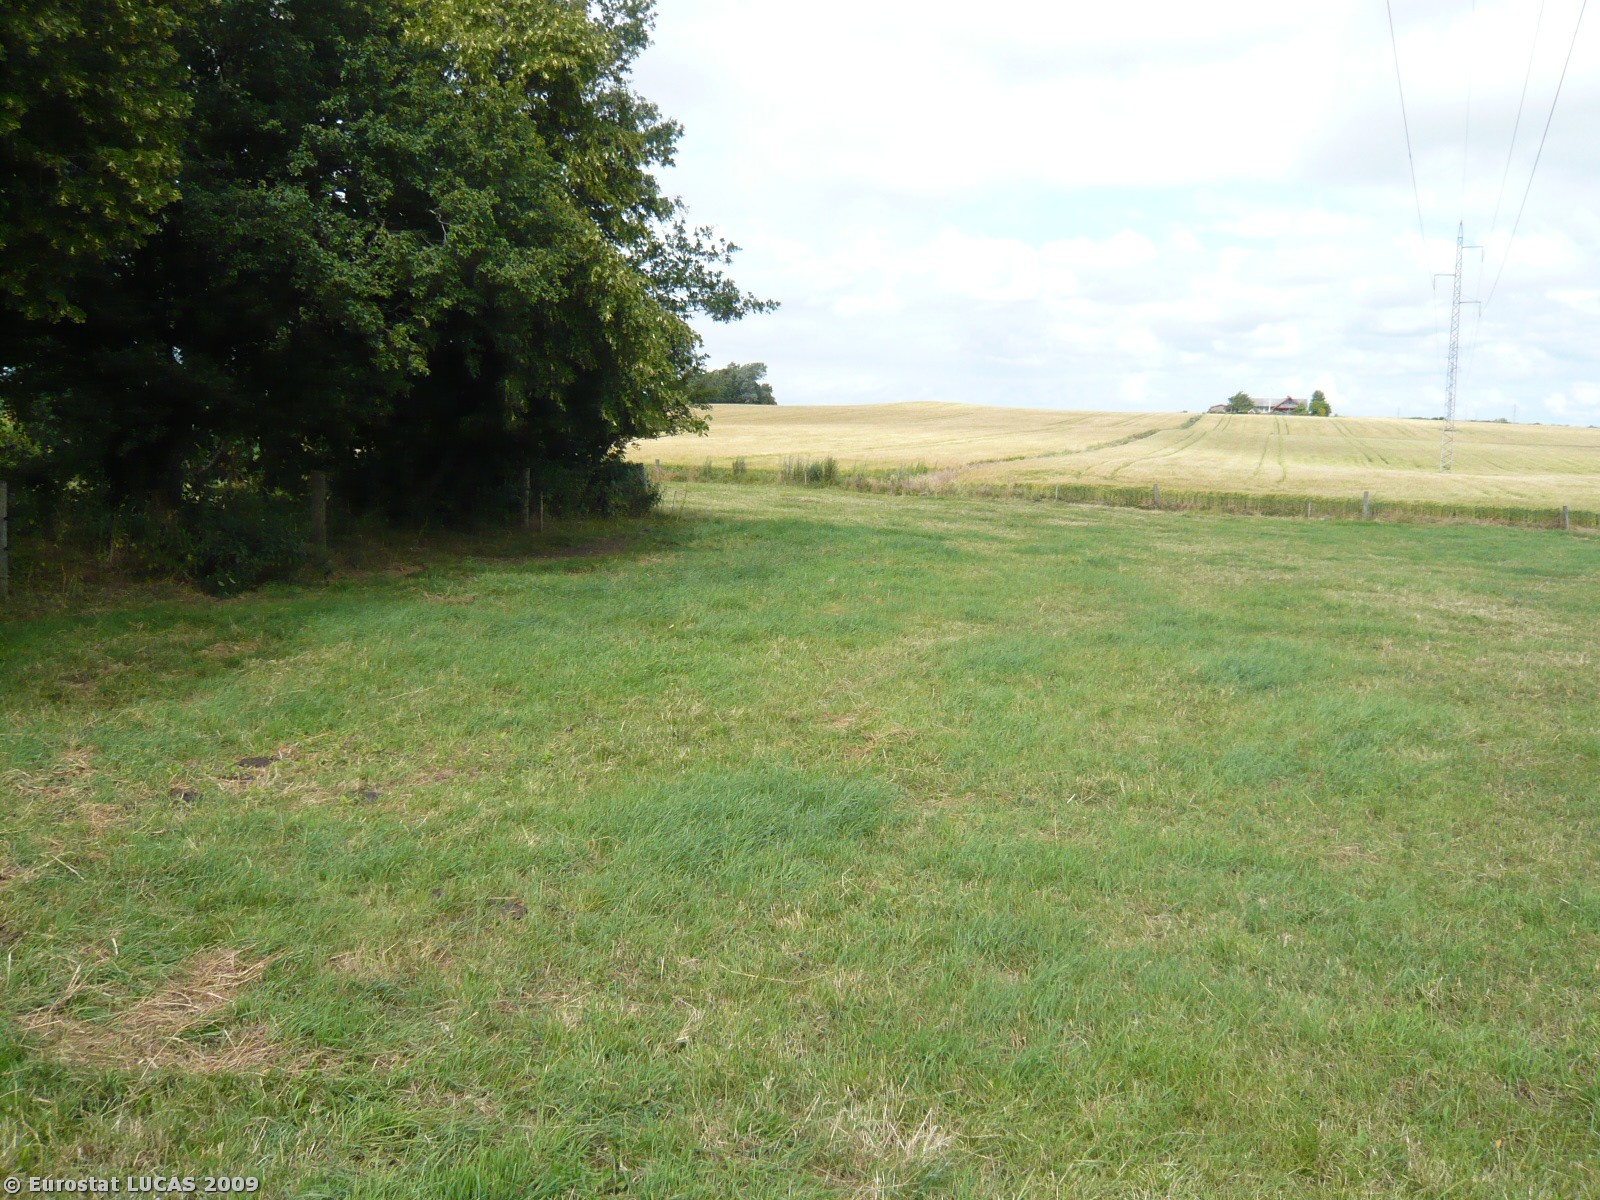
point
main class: Grassland
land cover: Grassland without tree/shrub cover
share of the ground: > 75 %
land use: Agriculture (excluding fallow land and kitchen gardens)
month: July
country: DK
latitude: 55.6073
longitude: 11.1577
